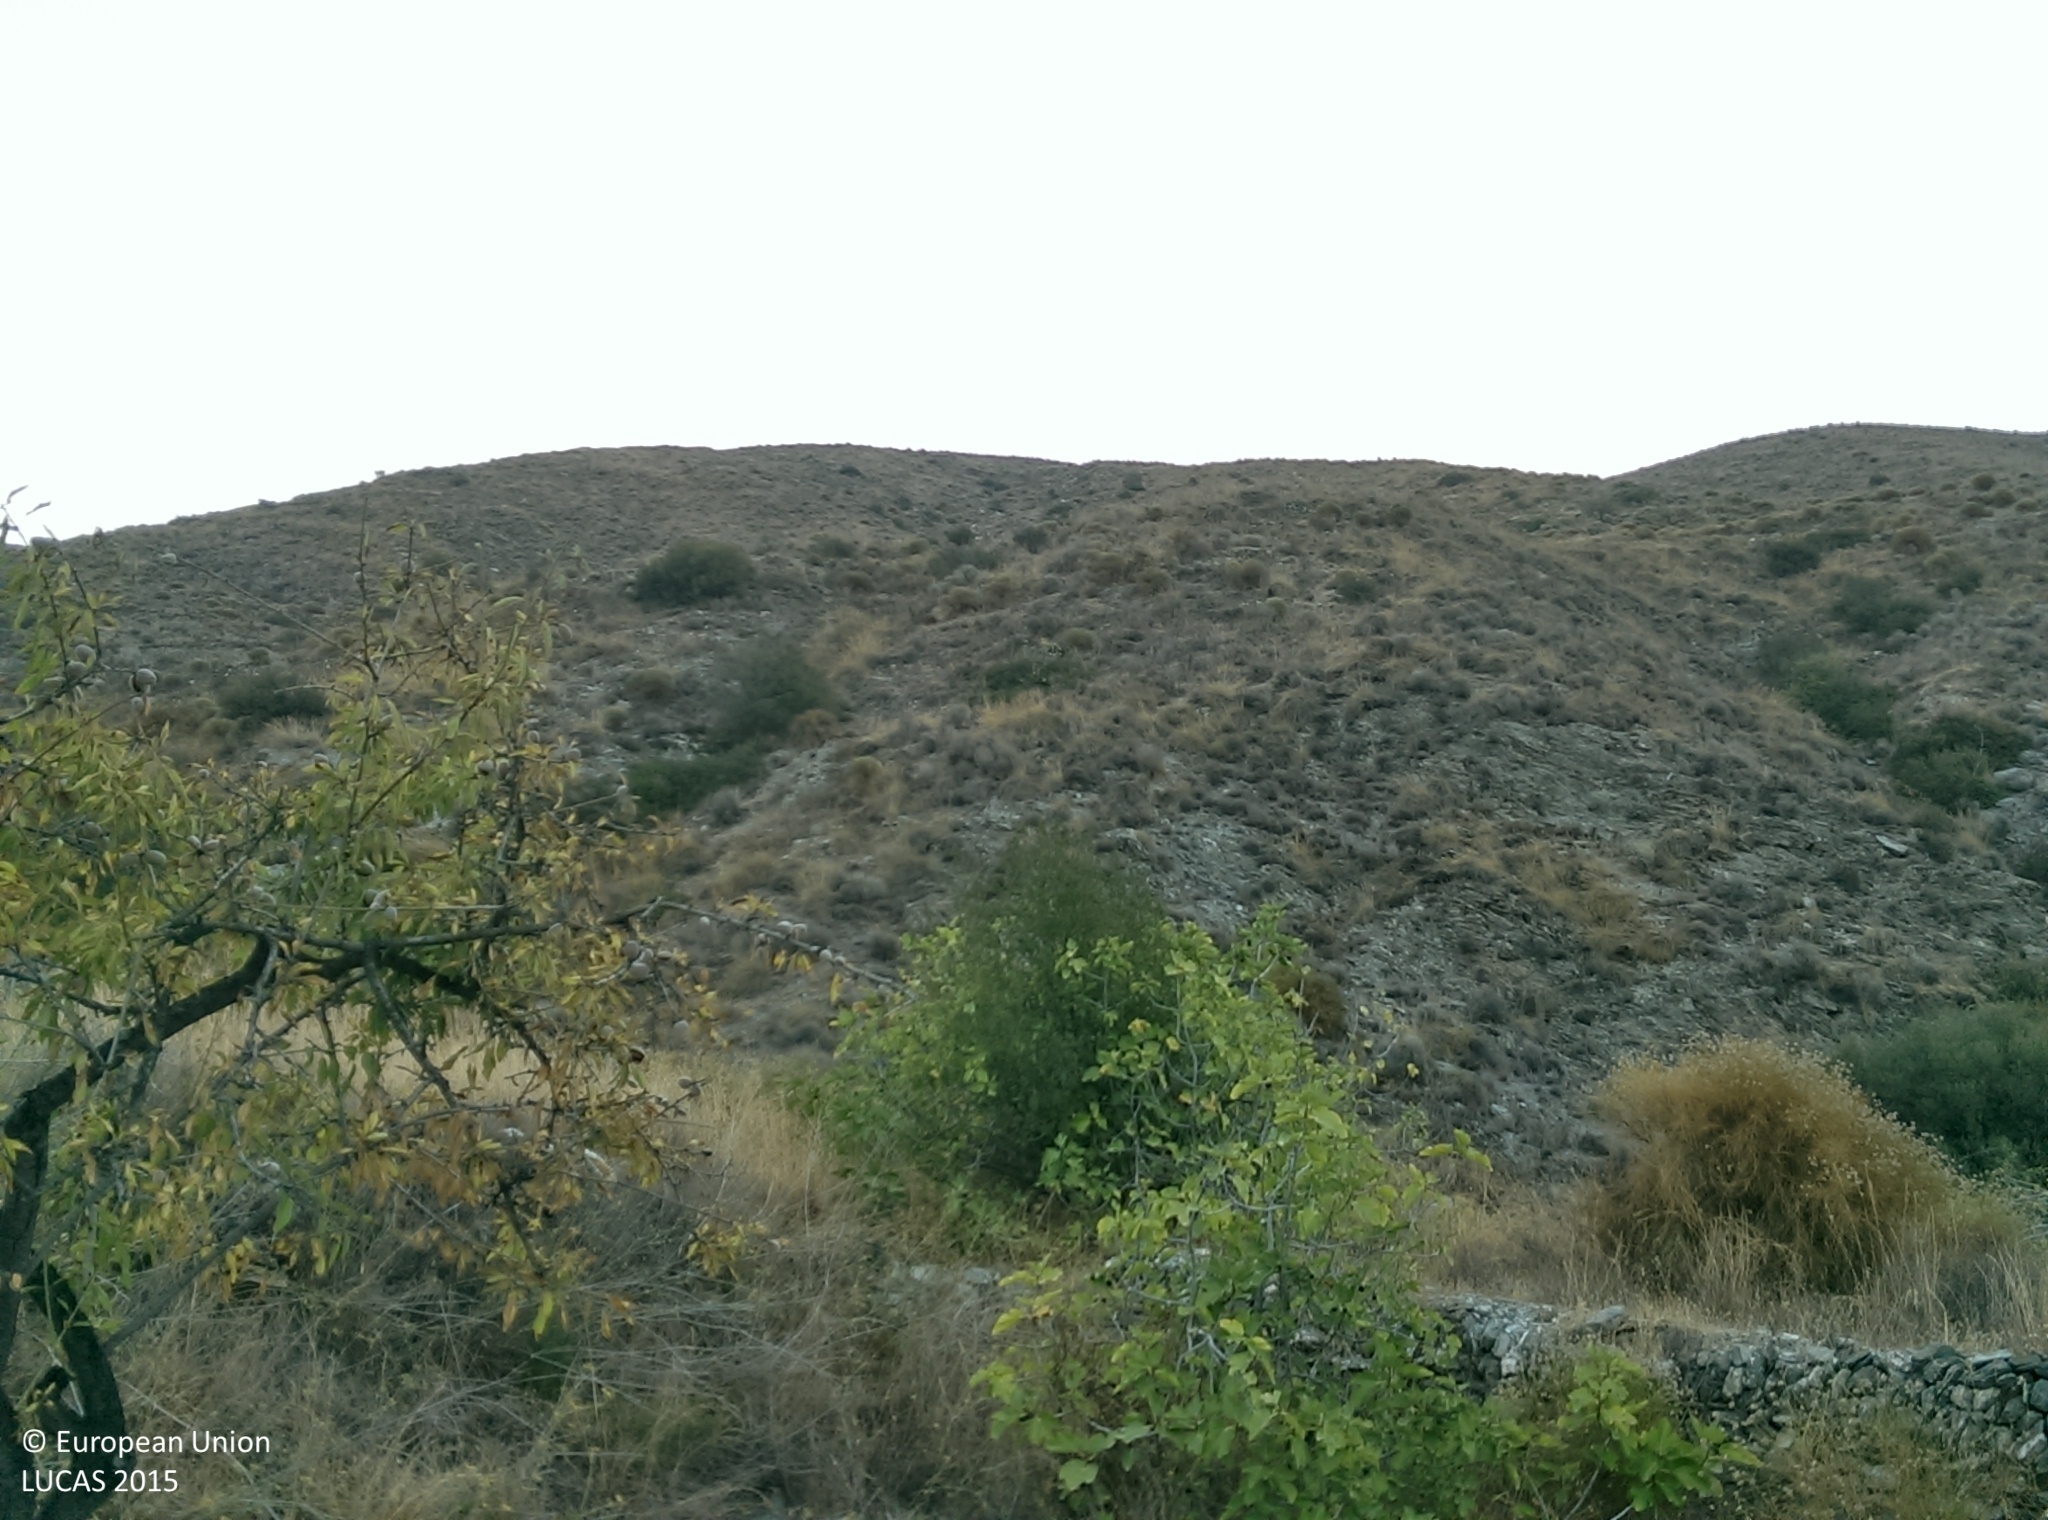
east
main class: Cropland
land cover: Nuts trees
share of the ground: 10 - 25 %
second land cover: Other bare soil
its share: > 75 %
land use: Agriculture (excluding fallow land and kitchen gardens)
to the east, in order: Nuts trees; Other bare soil; Dry stone walls; Shrubland with sparse tree cover; Grassland without tree/shrub cover; Nuts trees; Shrubland with sparse tree cover
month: August
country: ES
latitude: 36.7759
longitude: -3.1438
